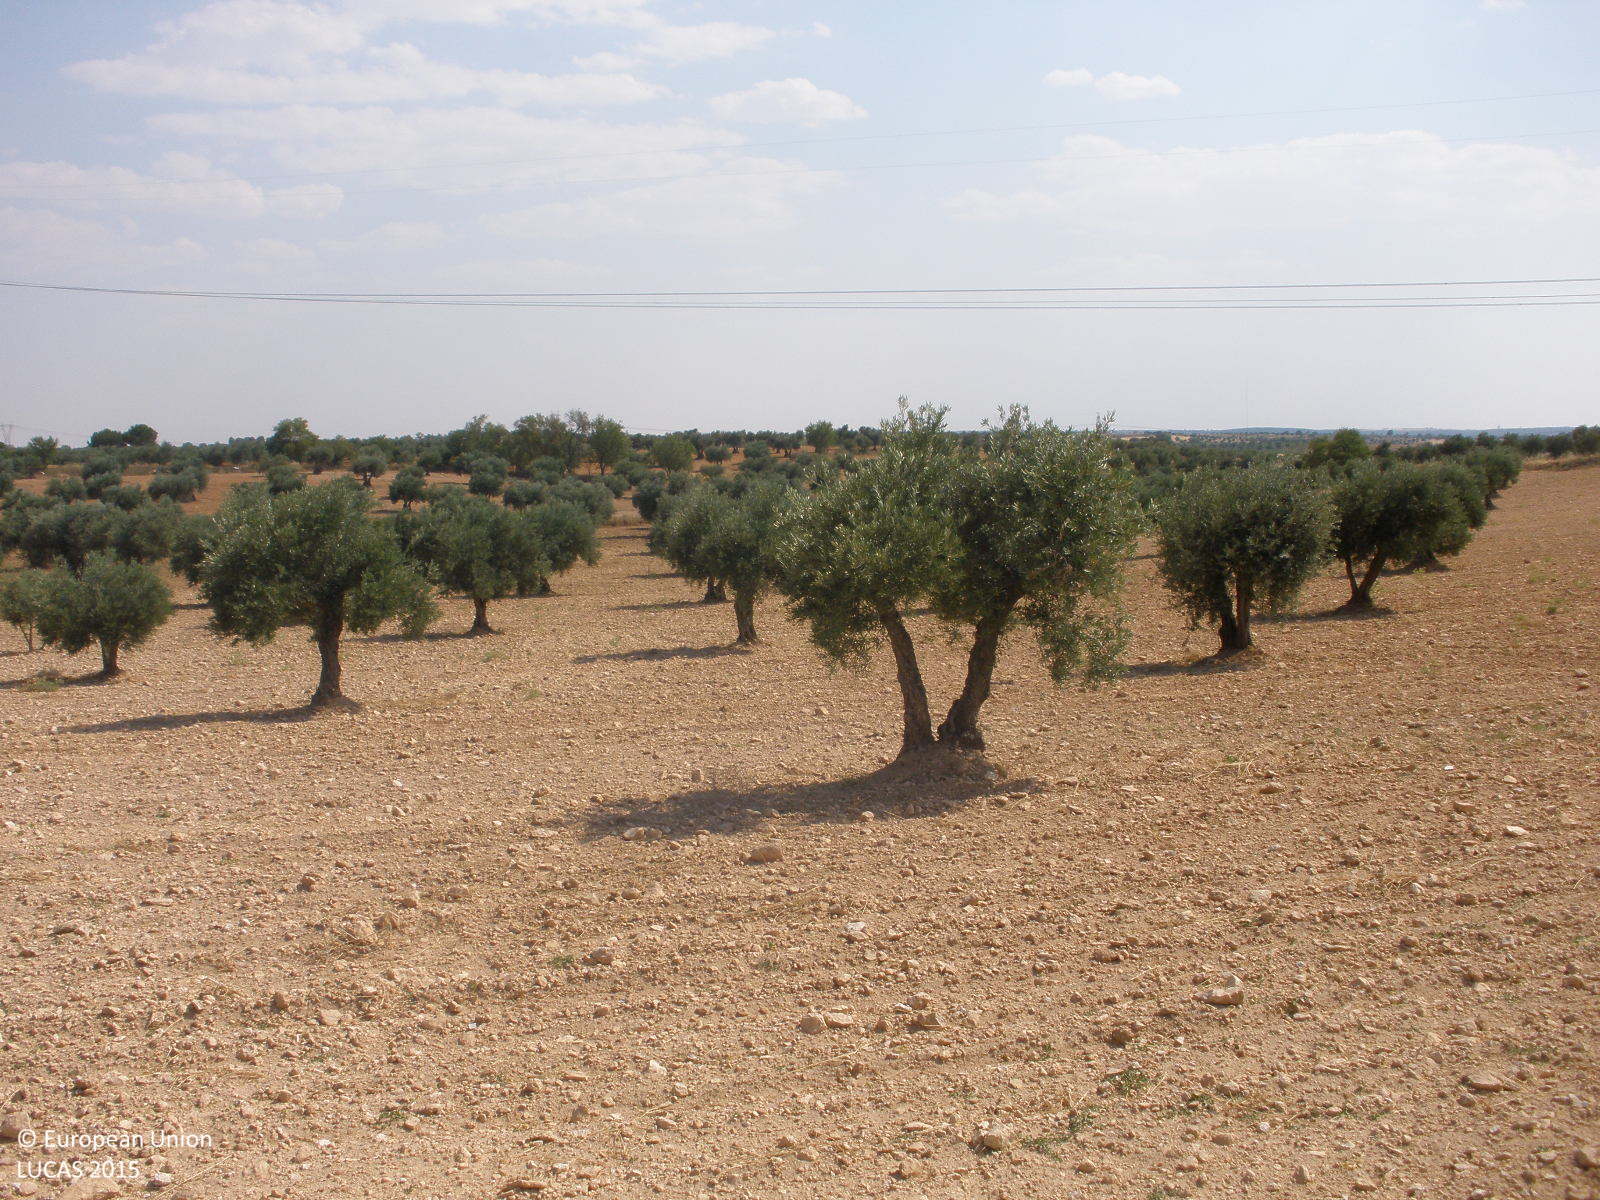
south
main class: Cropland
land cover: Olive groves
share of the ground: 10 - 25 %
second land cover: Other bare soil
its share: > 75 %
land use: Agriculture (excluding fallow land and kitchen gardens)
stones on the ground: 10 - 25 %
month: June
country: ES
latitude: 40.1796
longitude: -3.3121
